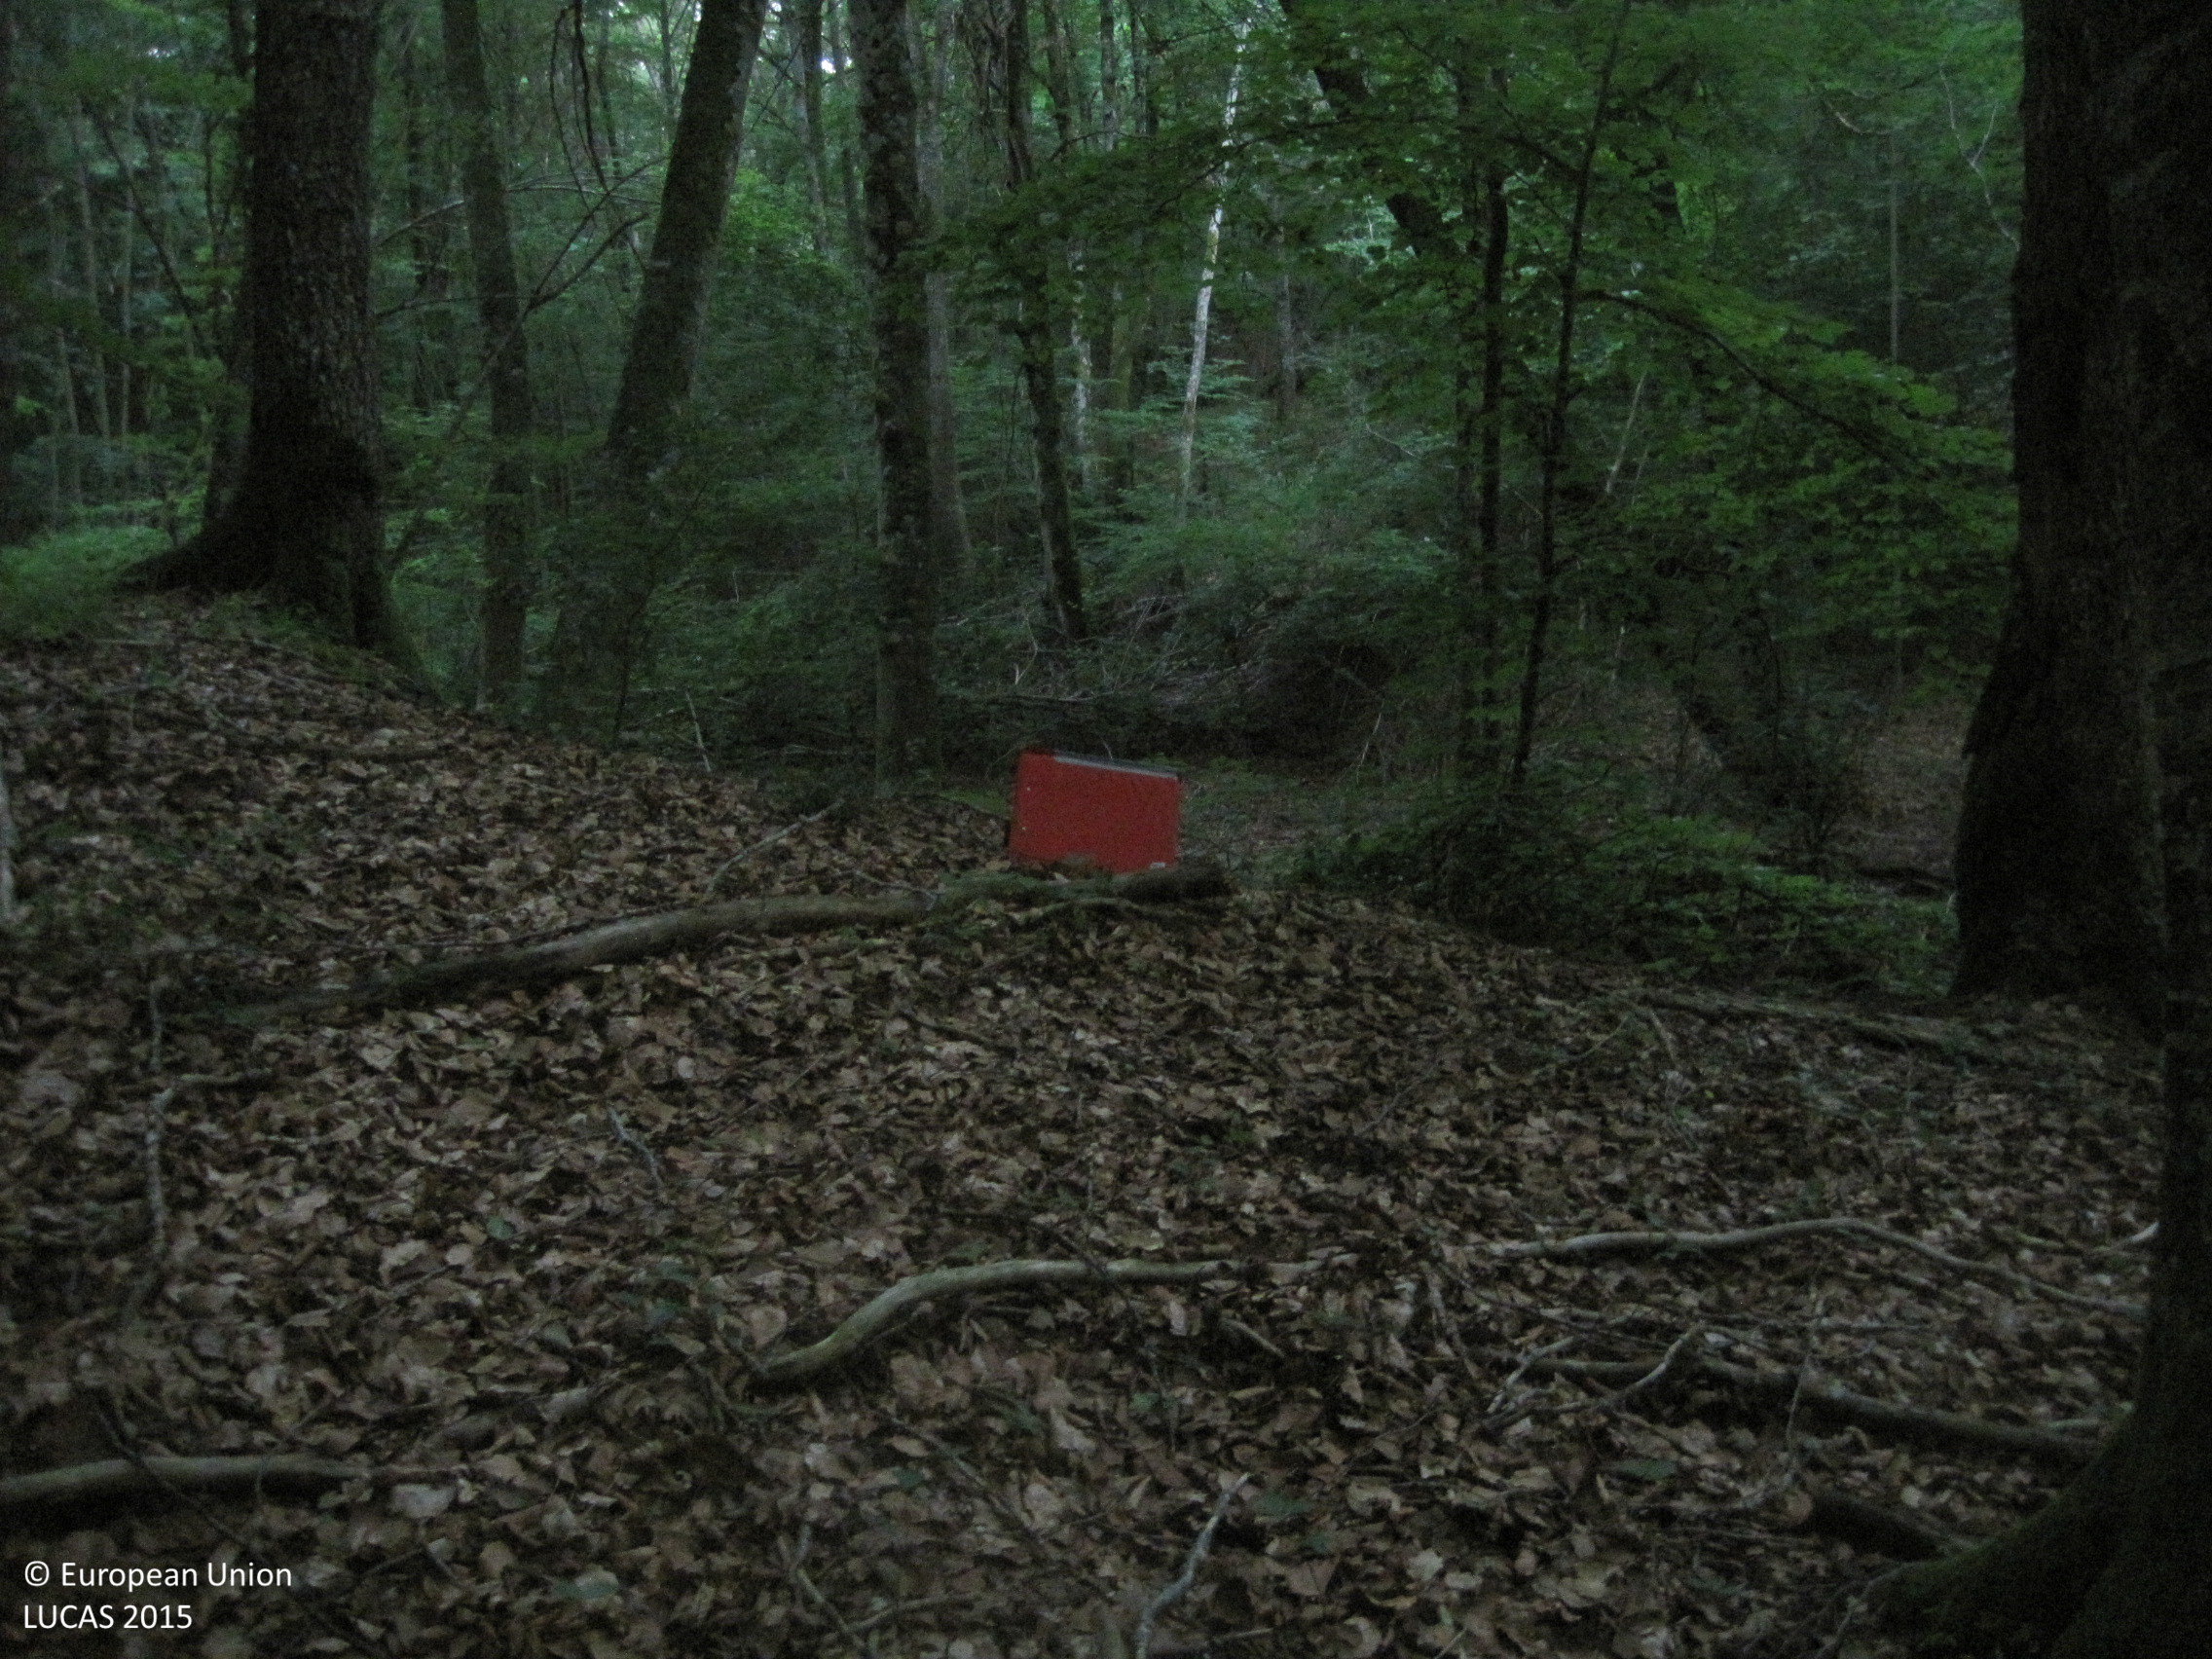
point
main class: Woodland
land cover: Broadleaved woodland
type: beech forest
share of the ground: > 75 %
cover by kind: broadleaved forest trees 100 %
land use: Forestry
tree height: > 5 m
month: June
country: ES
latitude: 42.9372
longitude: -1.7193
